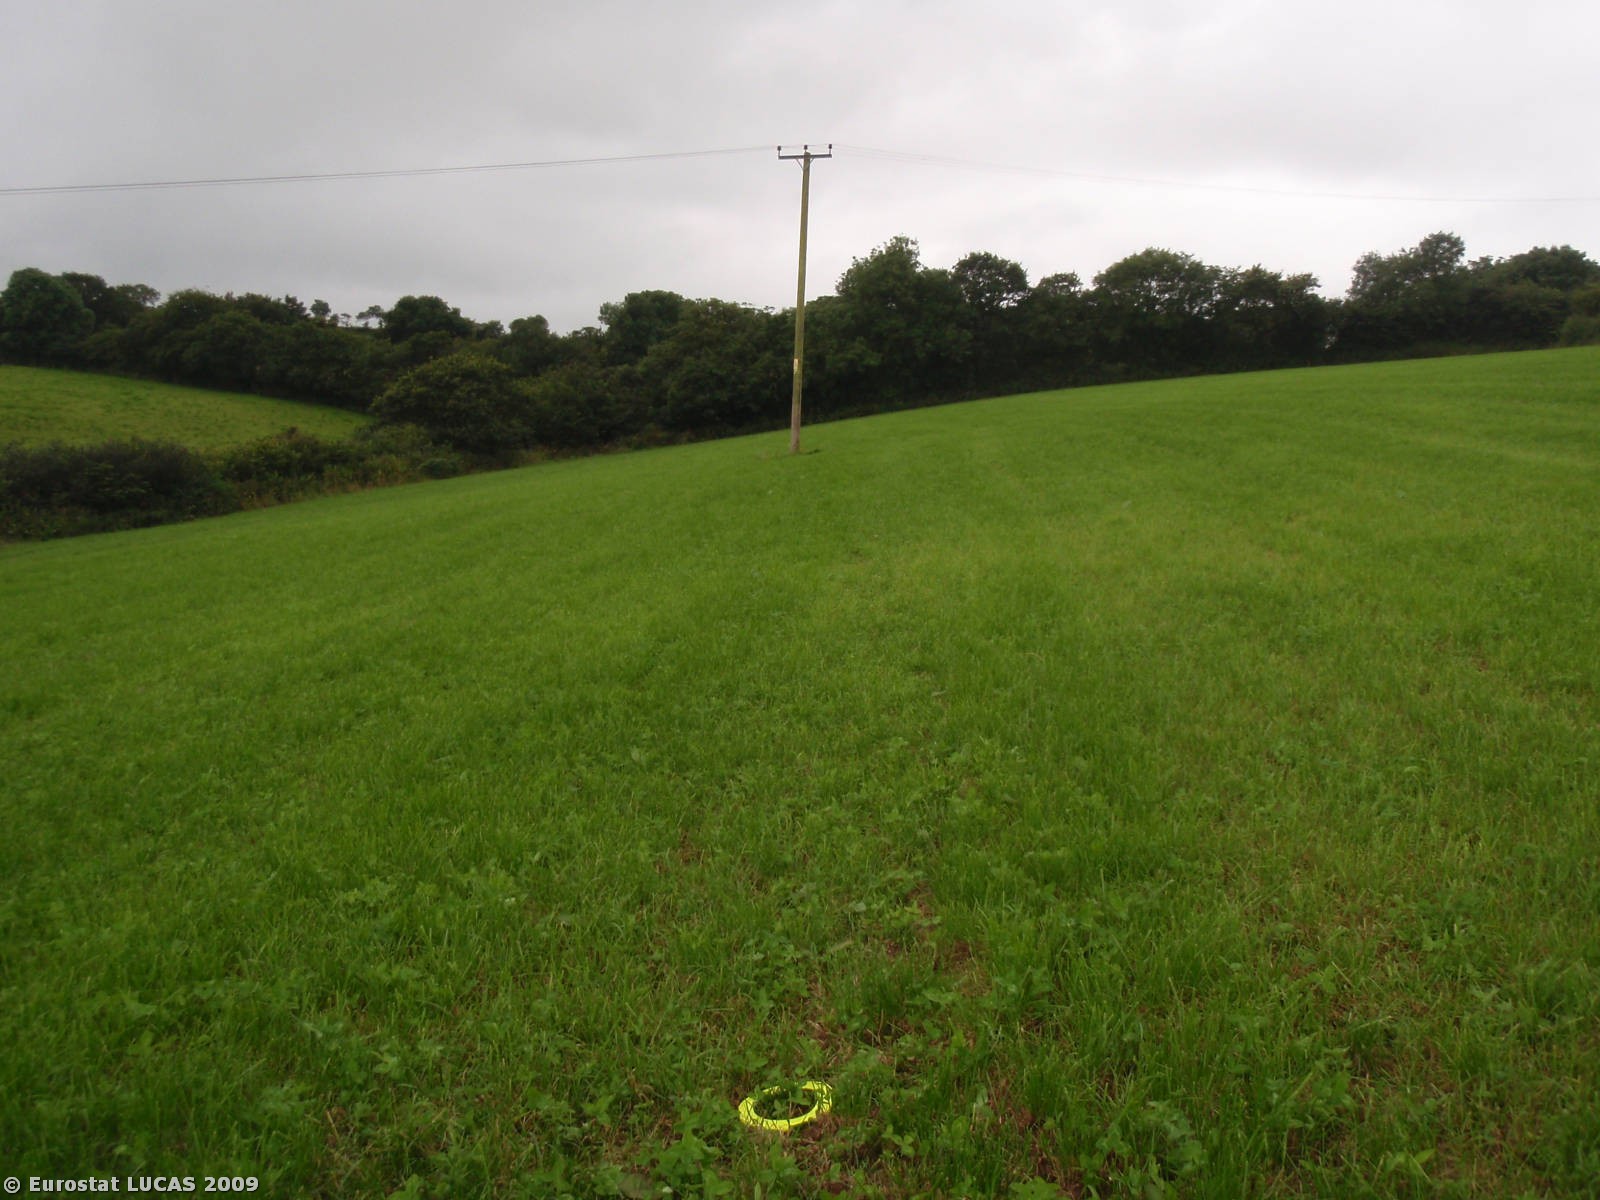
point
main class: Cropland
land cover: Clovers
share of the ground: 50 - 75 %
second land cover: Temporary grasslands
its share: 25 - 50 %
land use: Agriculture (excluding fallow land and kitchen gardens)
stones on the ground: < 10 %
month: July
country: GB
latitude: 50.7683
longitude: -4.3514
